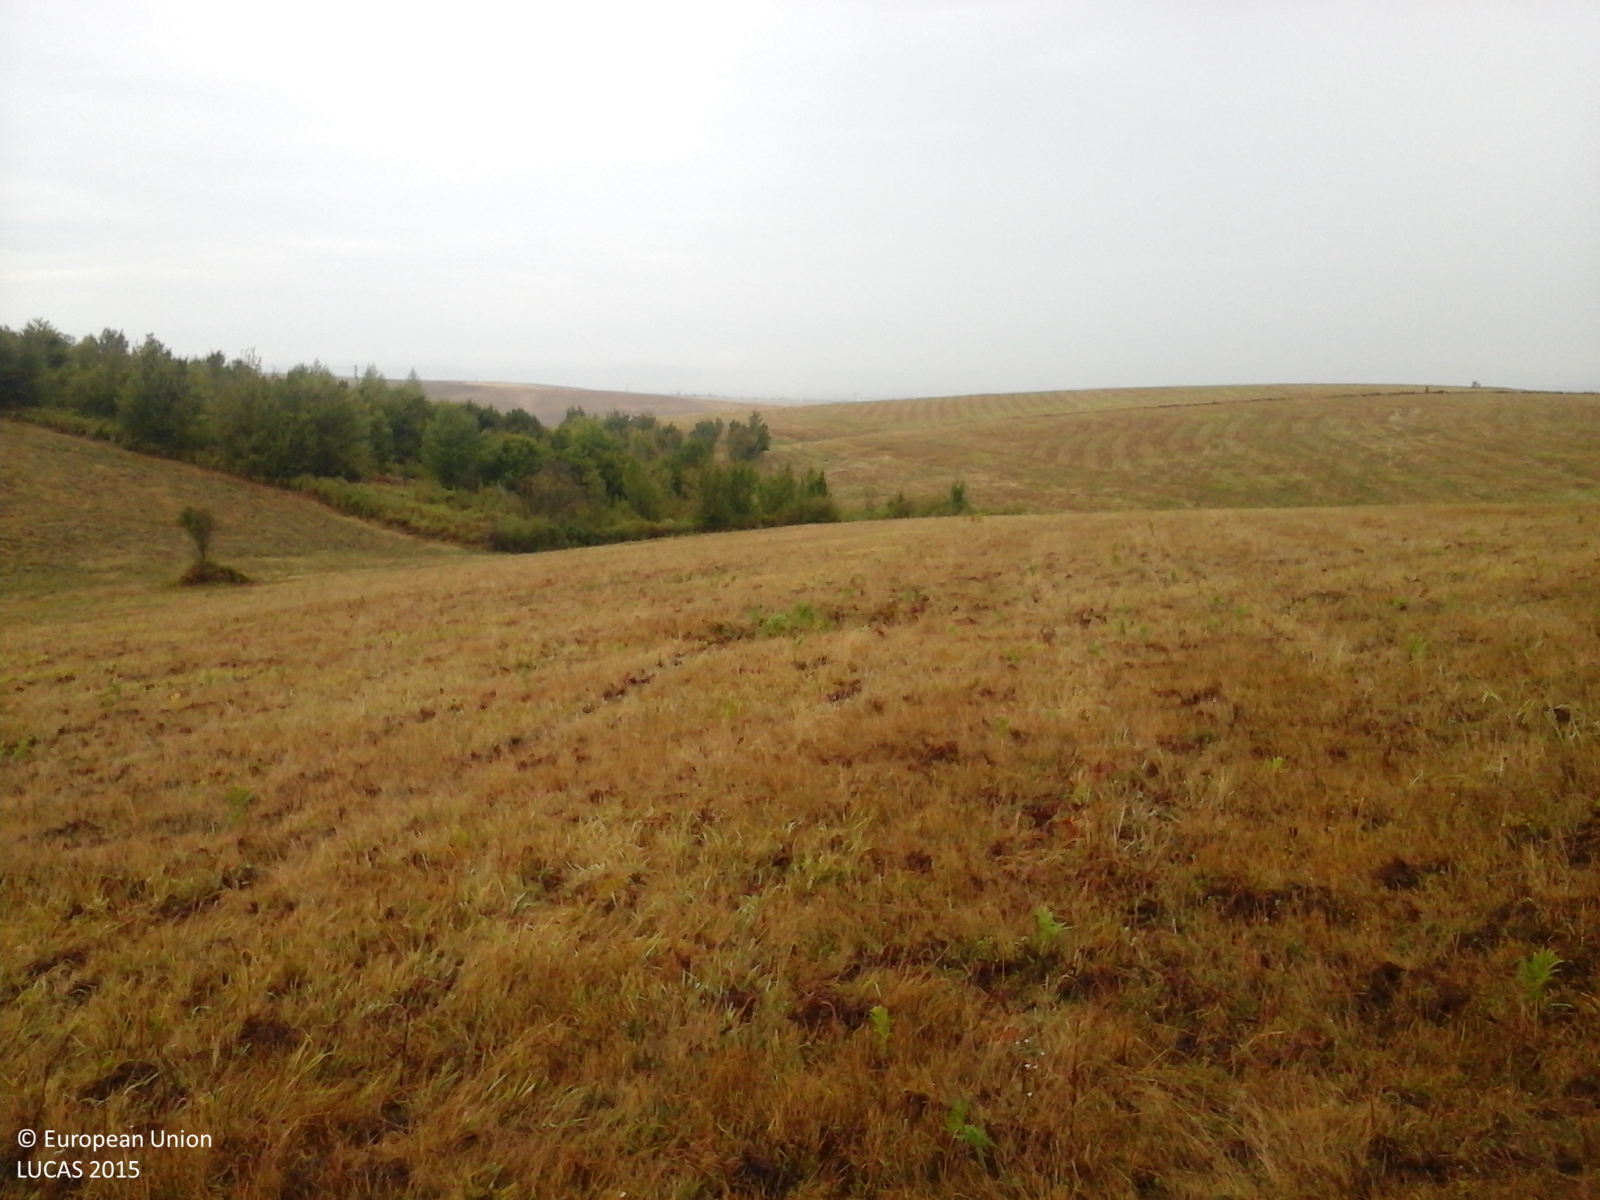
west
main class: Grassland
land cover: Grassland without tree/shrub cover
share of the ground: > 75 %
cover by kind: herbaceous plants 100 %
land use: Agriculture (excluding fallow land and kitchen gardens)
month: September
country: RO
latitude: 45.4732
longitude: 22.3096
